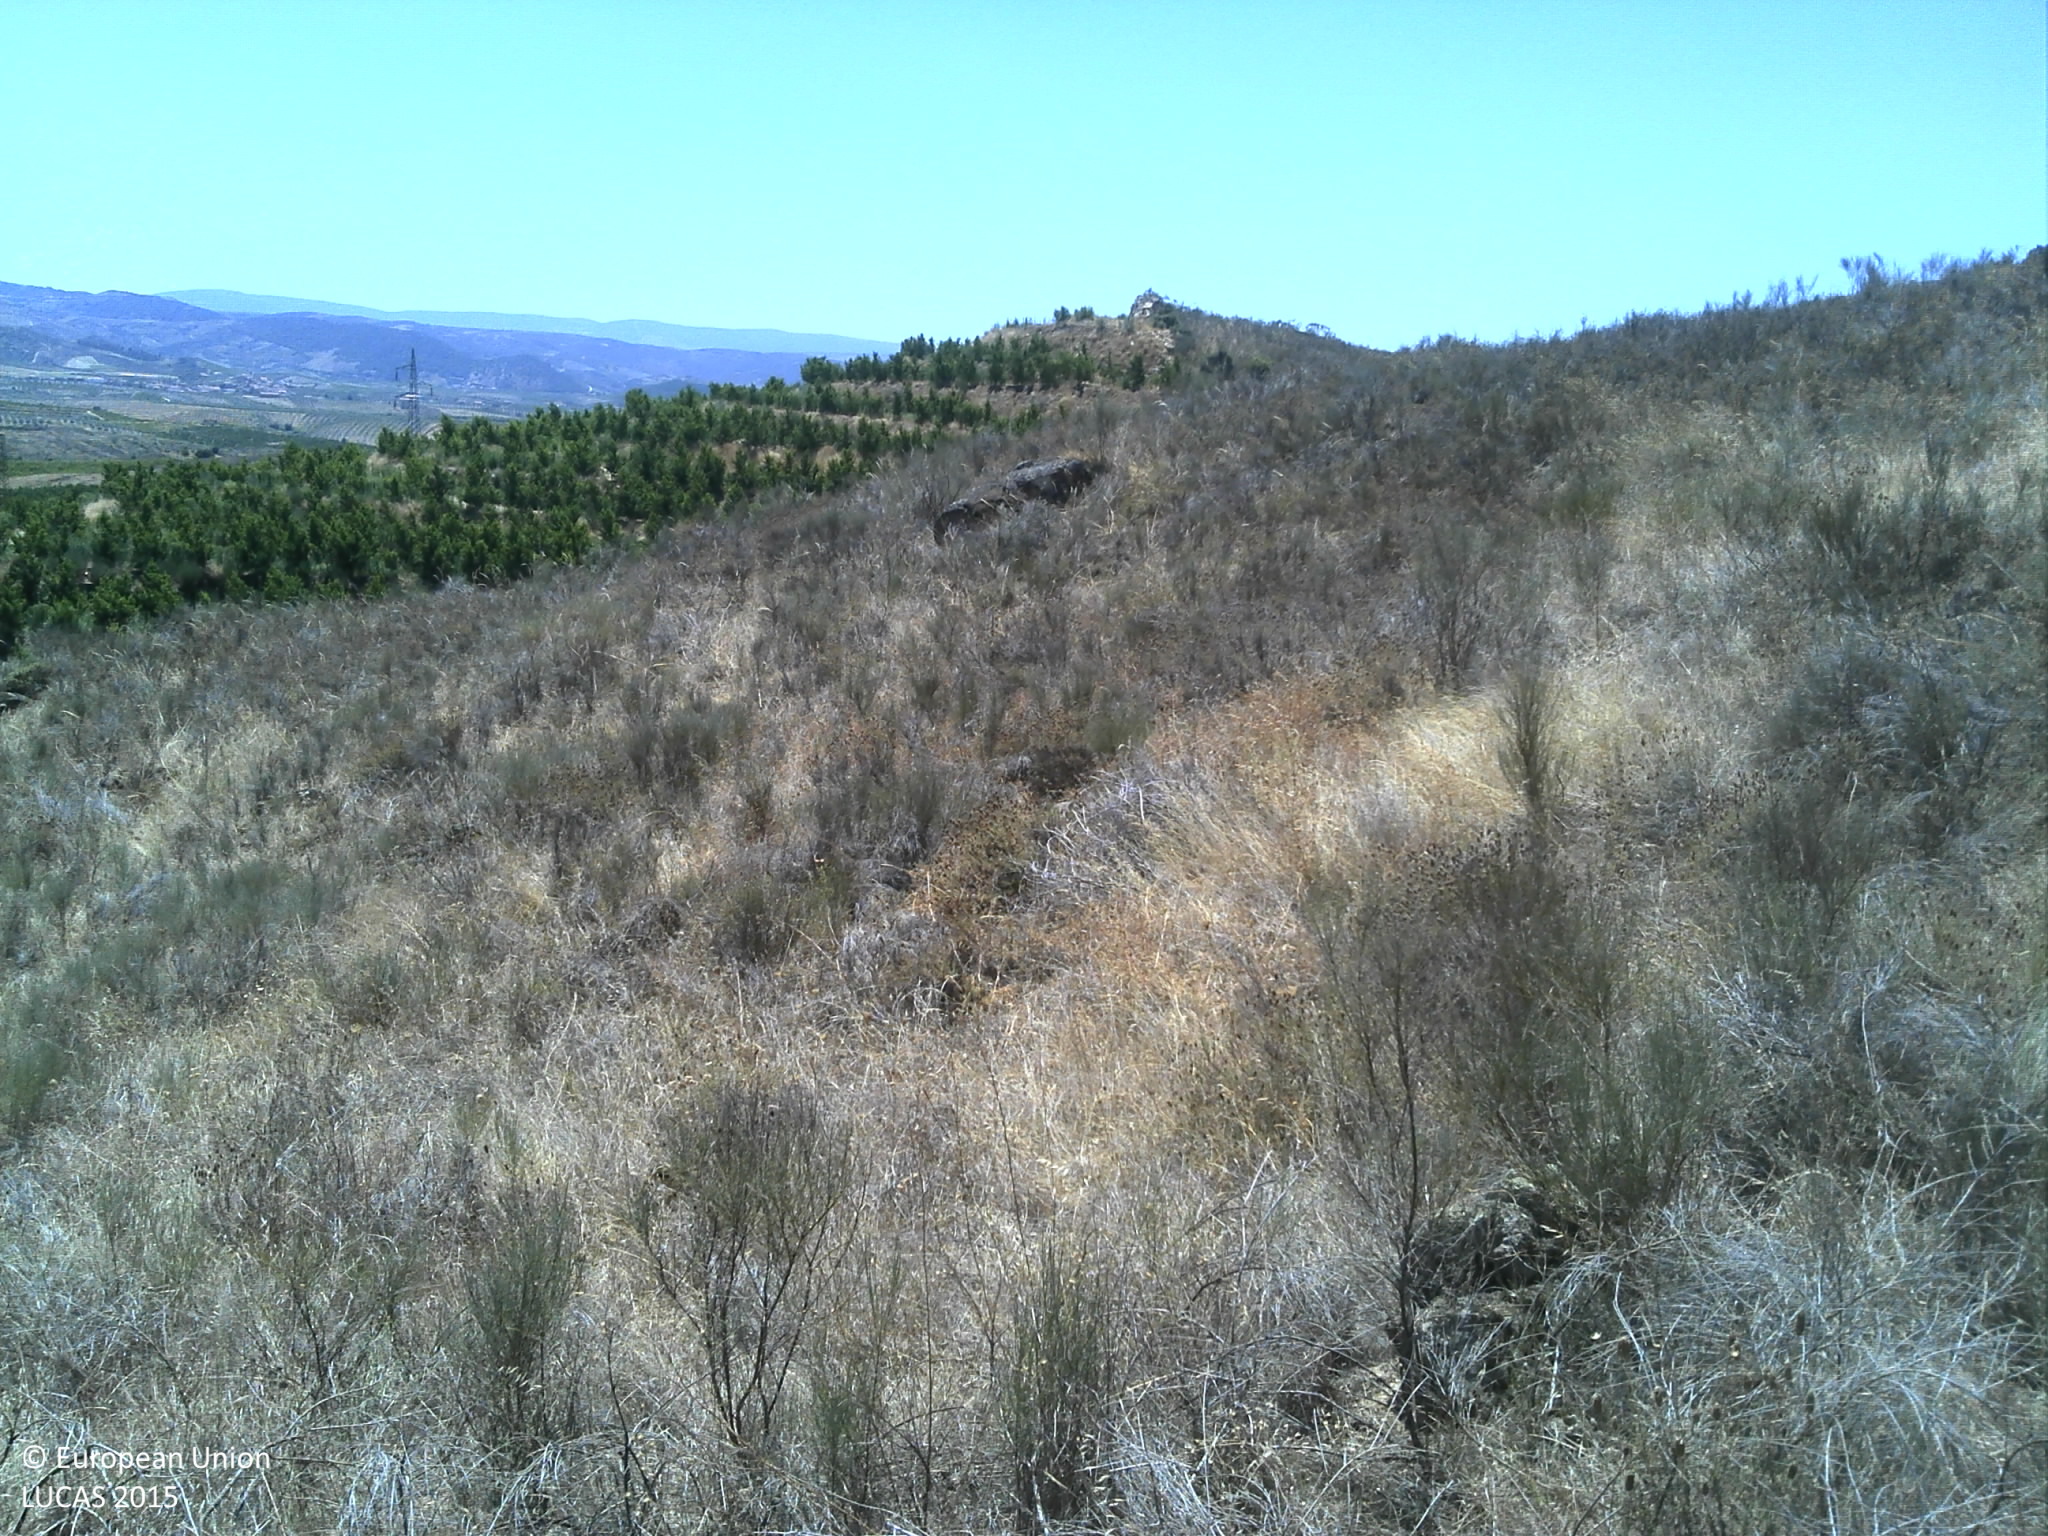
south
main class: Shrubland
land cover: Shrubland without tree cover
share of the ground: > 75 %
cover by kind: shrubs 100 %
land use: Semi-natural and natural areas not in use
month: July
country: PT
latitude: 41.3787
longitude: -7.0575
